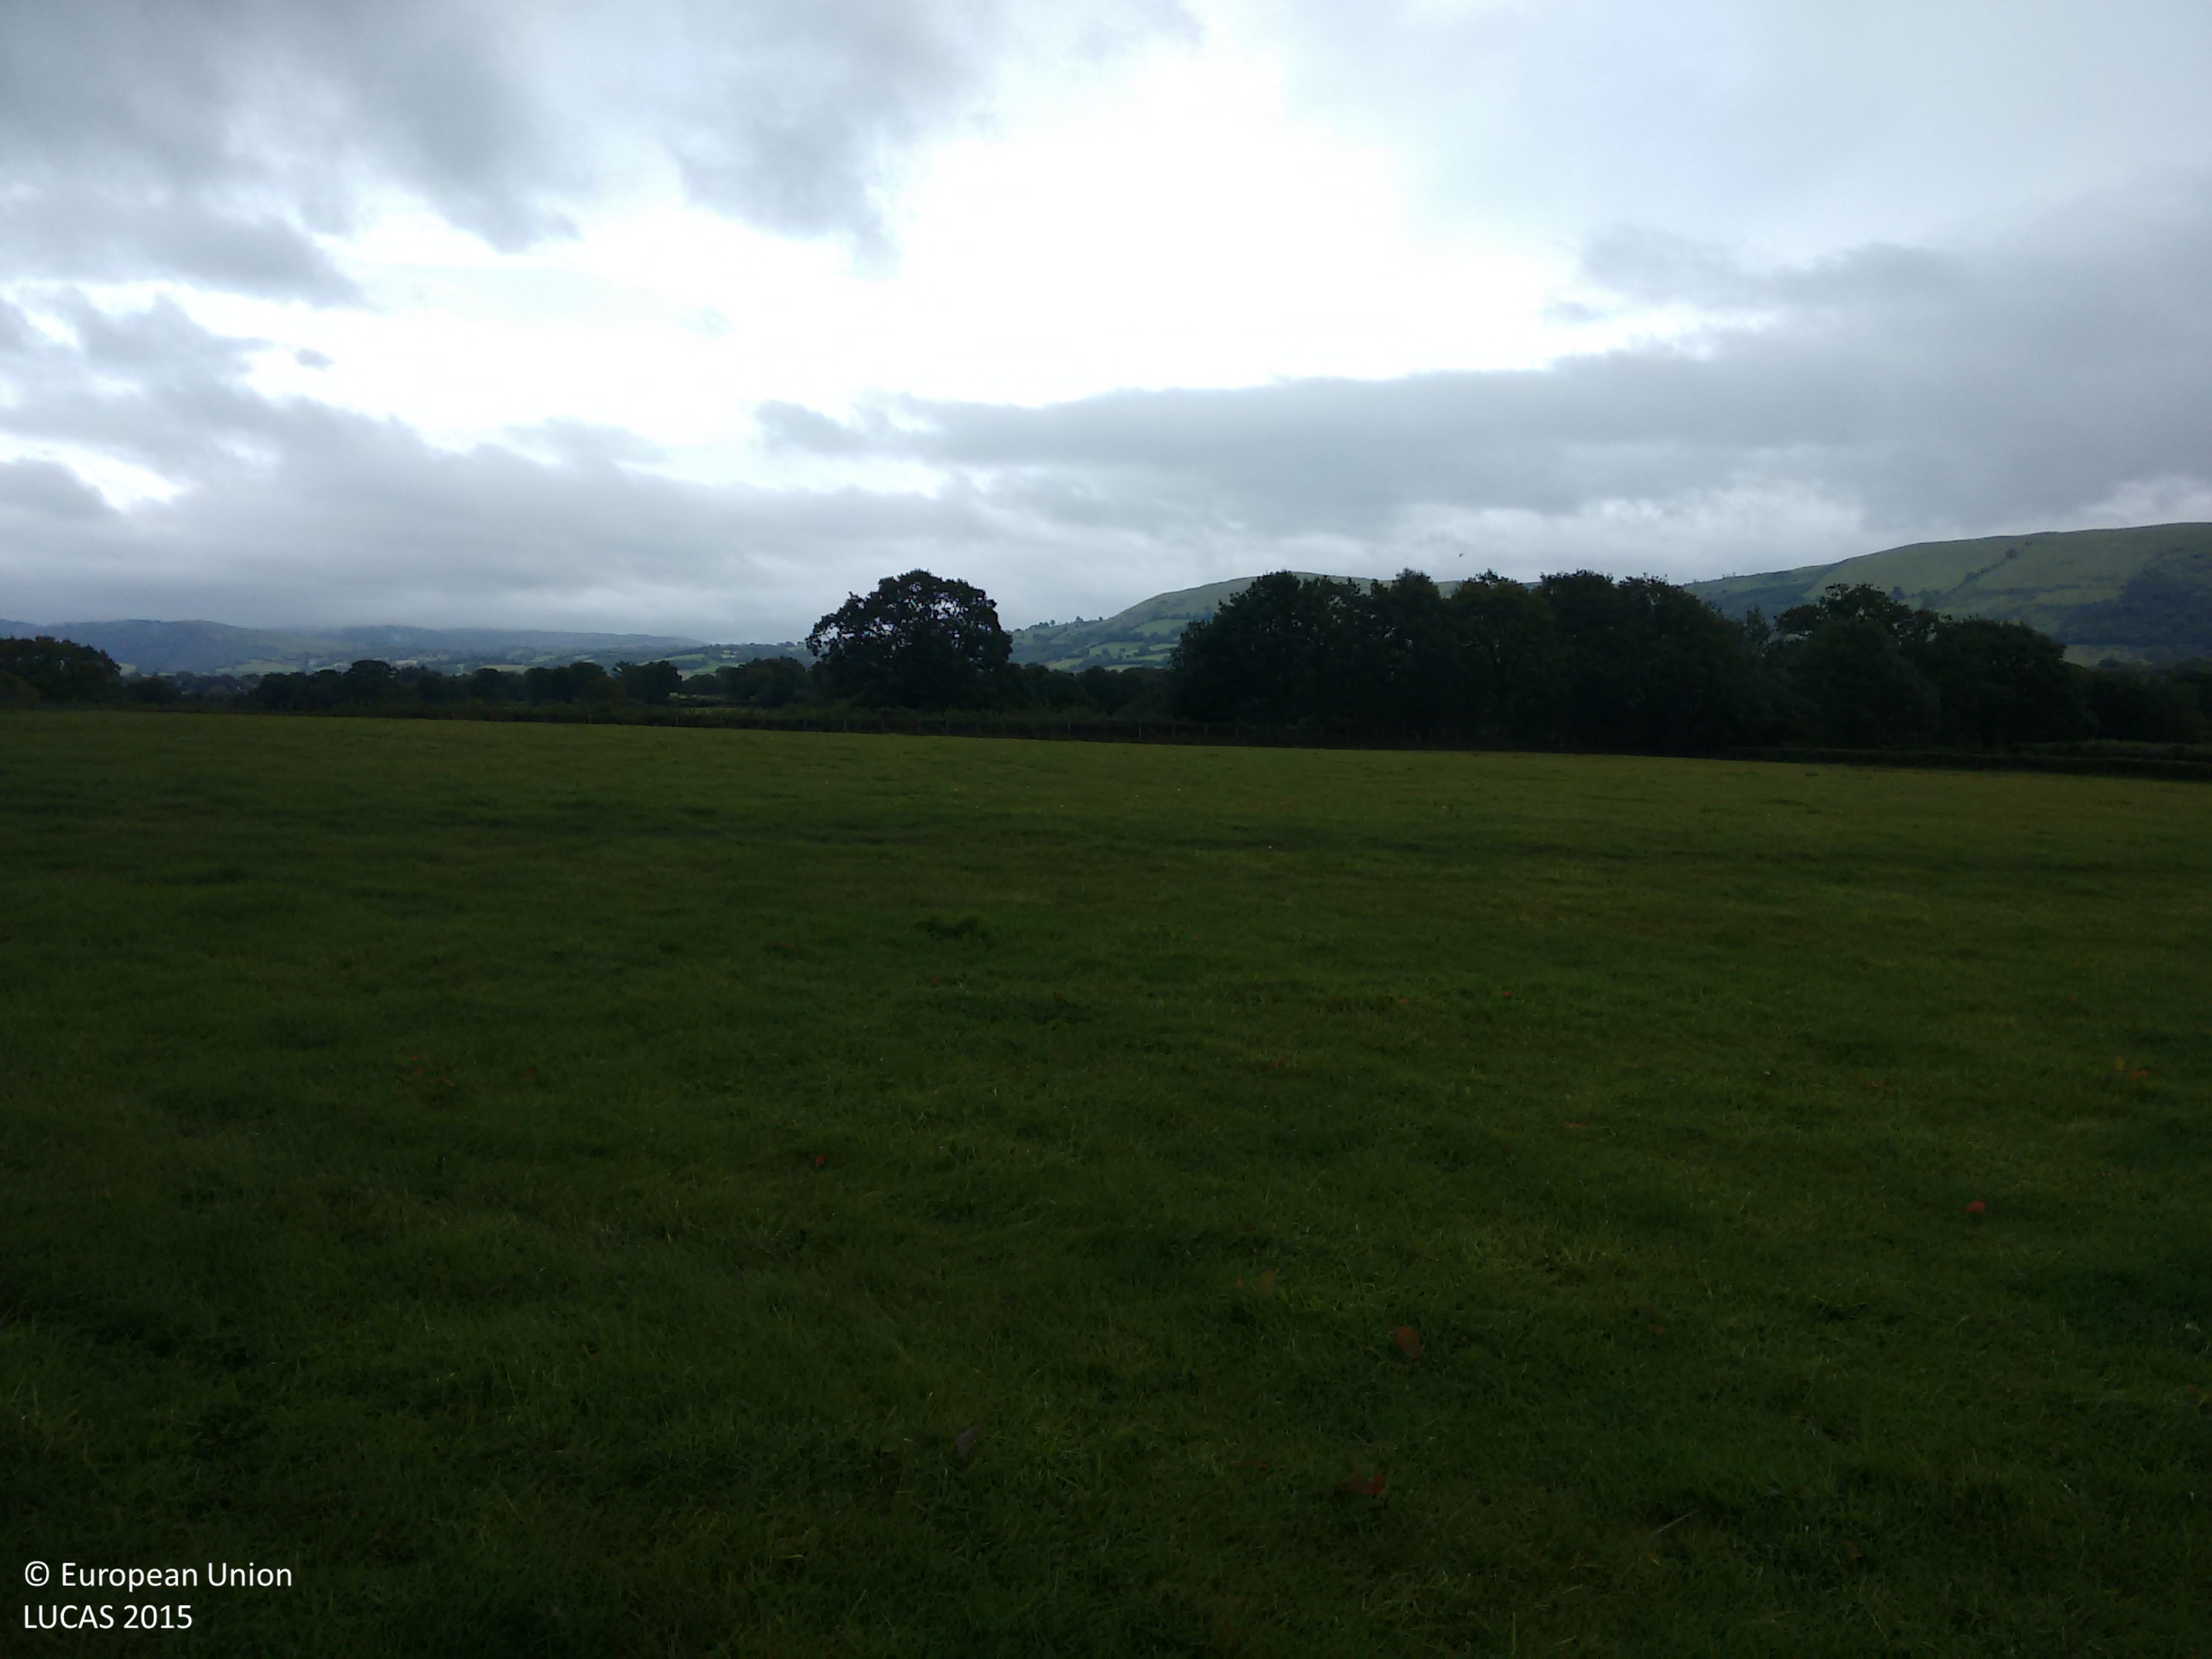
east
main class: Grassland
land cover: Grassland without tree/shrub cover
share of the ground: > 75 %
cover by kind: herbaceous plants 100 %
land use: Agriculture (excluding fallow land and kitchen gardens)
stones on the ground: < 10 %
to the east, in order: Grassland without tree/shrub cover; Fences; Lines of trees; Ditches and canals; Grass margins; Paved roads, cycling and walking lanes; Grass margins; Managed hedges; Fences; Grassland without tree/shrub cover
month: September
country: GB
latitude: 52.0363
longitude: -3.8380
